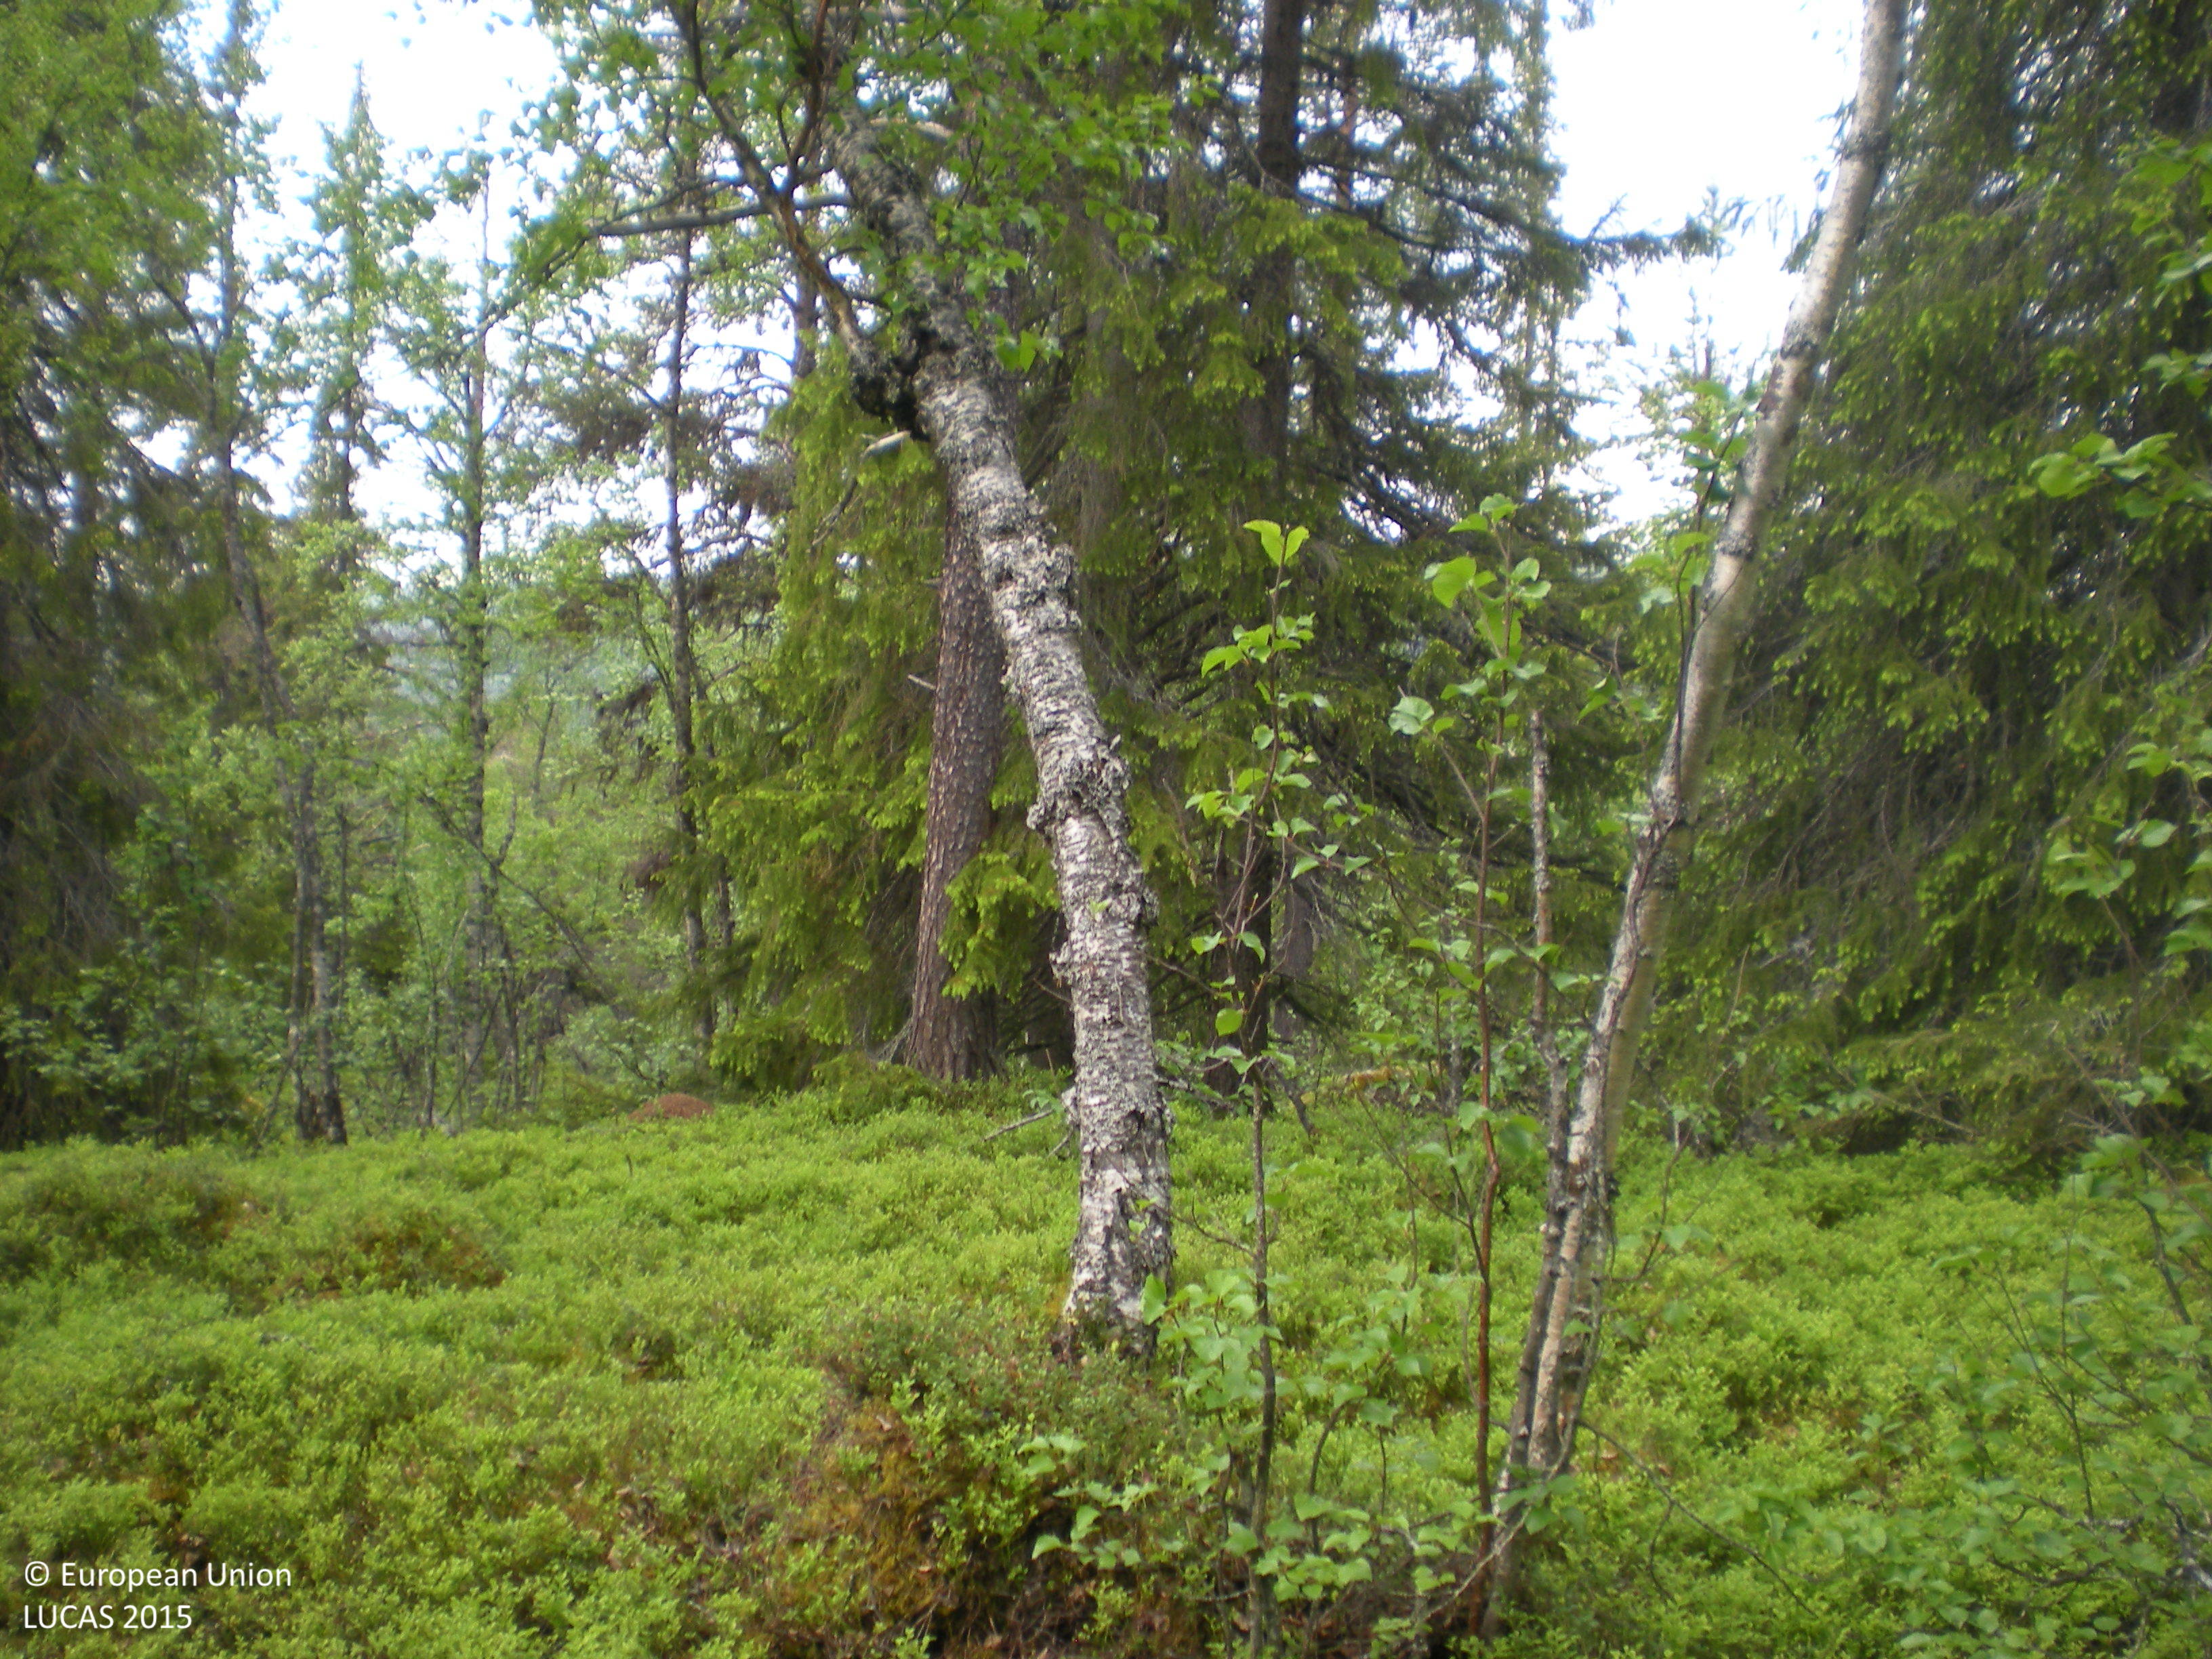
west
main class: Woodland
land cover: Other mixed woodland
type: boreal forest
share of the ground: 50 - 75 %
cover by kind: coniferous forest trees 50 %, broadleaved forest trees 20 %, shrubs 20 %, lichens and mosses 10 %
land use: Forestry
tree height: > 5 m
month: July
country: SE
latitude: 66.1611
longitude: 17.1615
